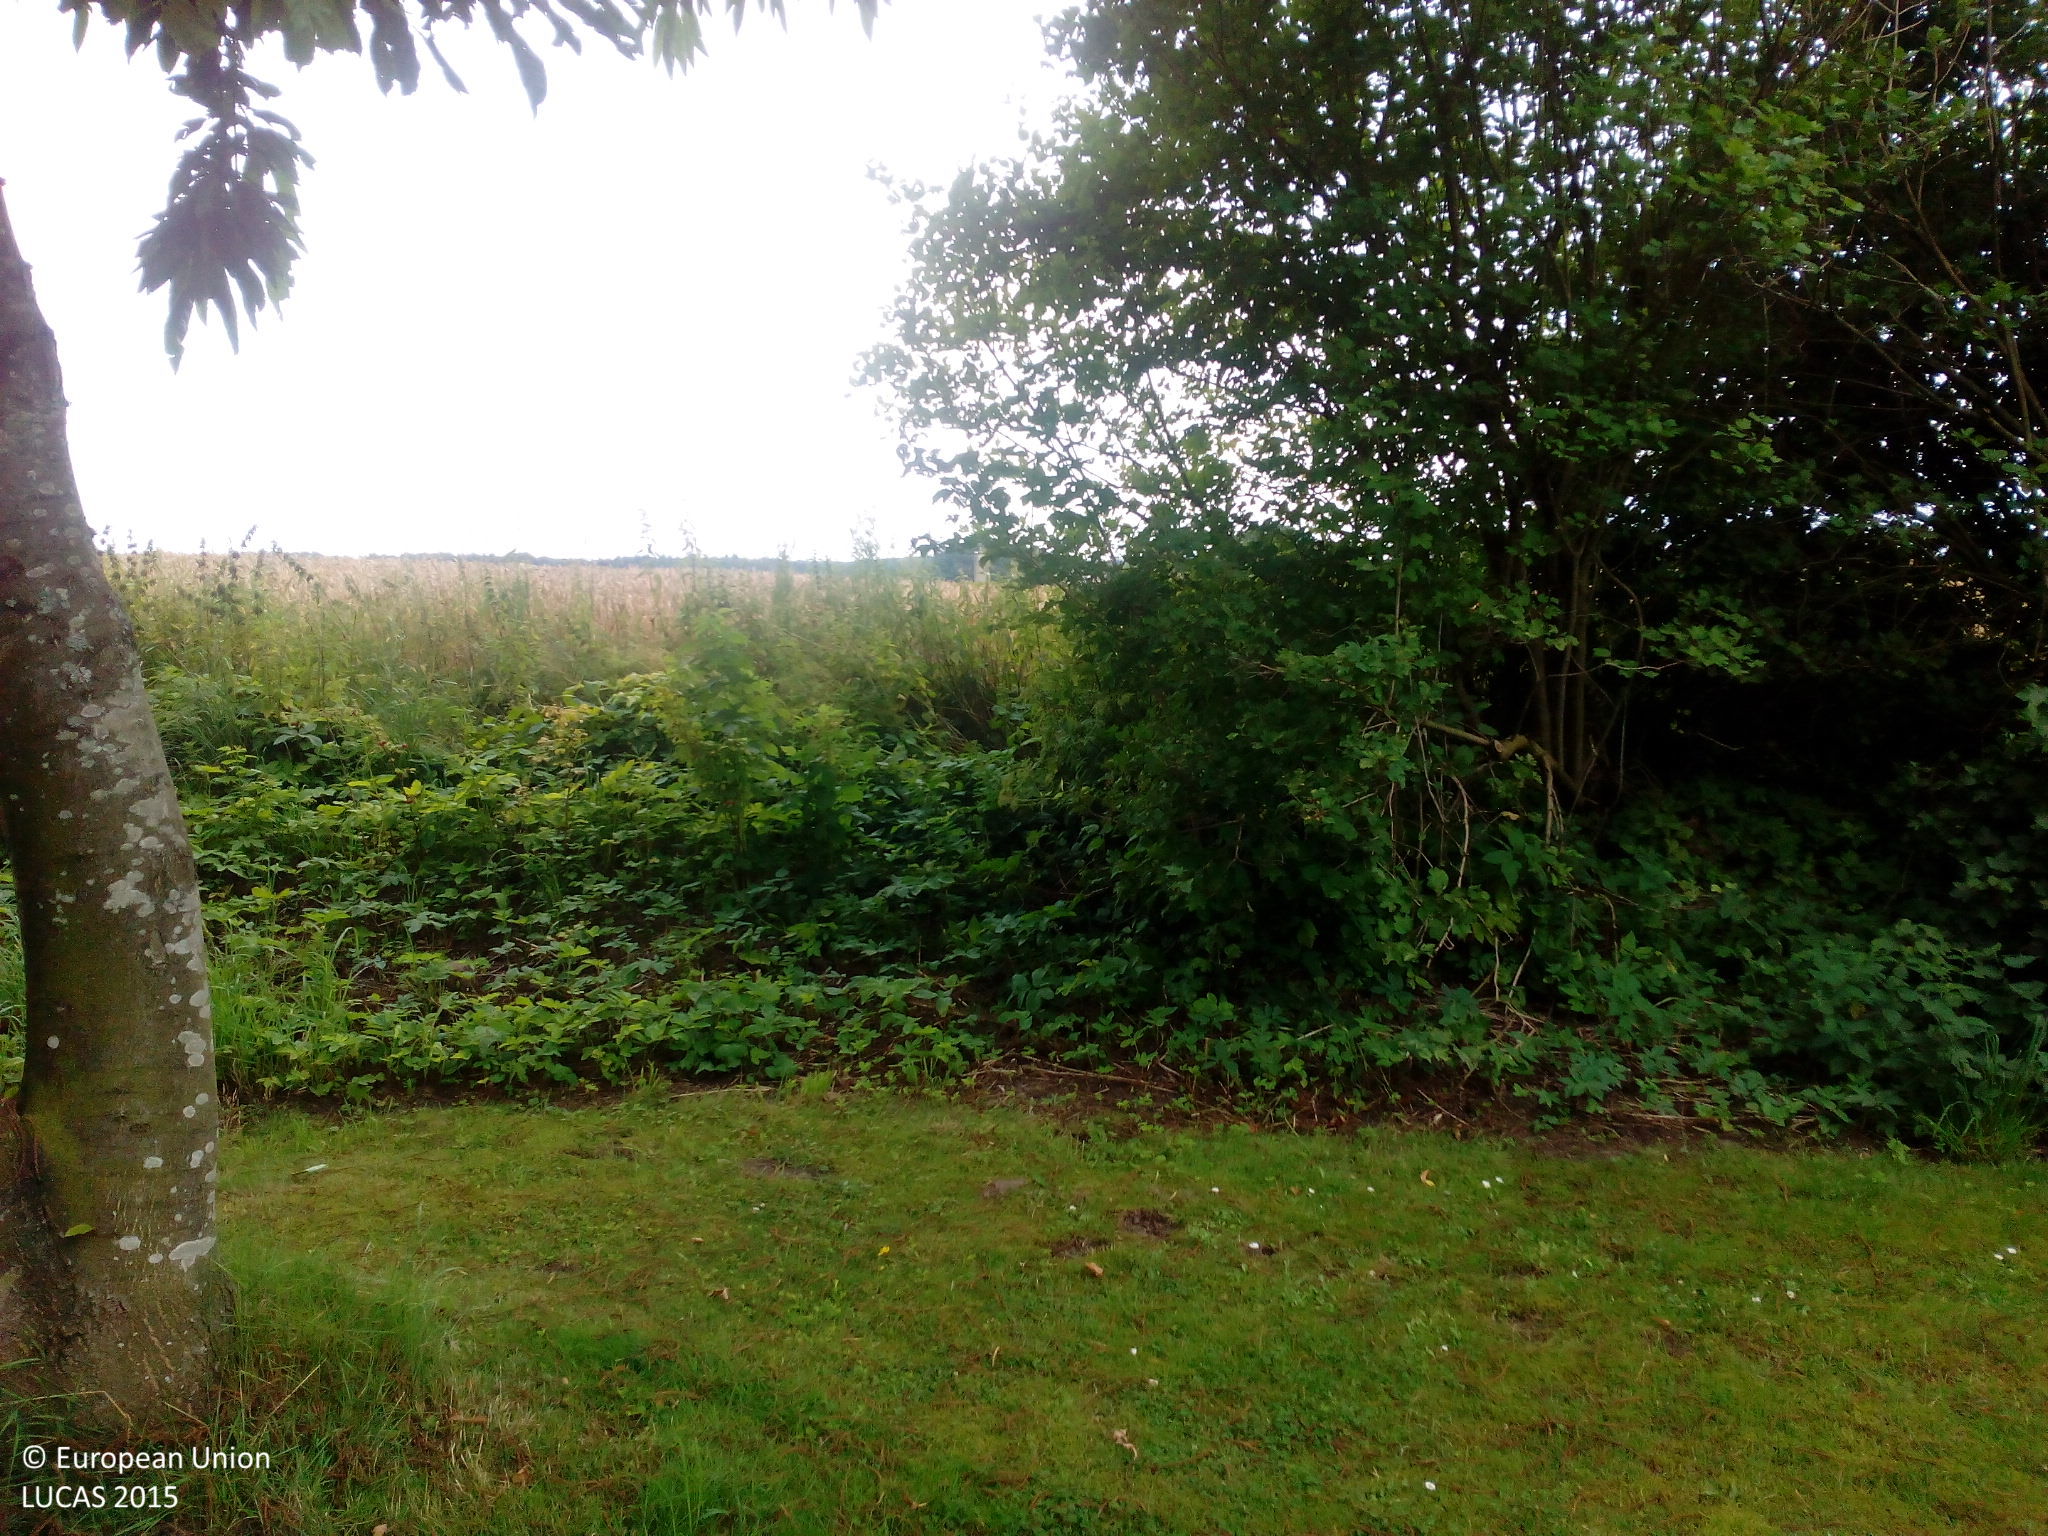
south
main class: Woodland
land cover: Broadleaved woodland
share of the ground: 10 - 25 %
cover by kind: herbaceous plants 85 %, broadleaved forest trees 15 %
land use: Residential
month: August
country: DK
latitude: 55.5442
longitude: 11.9160
